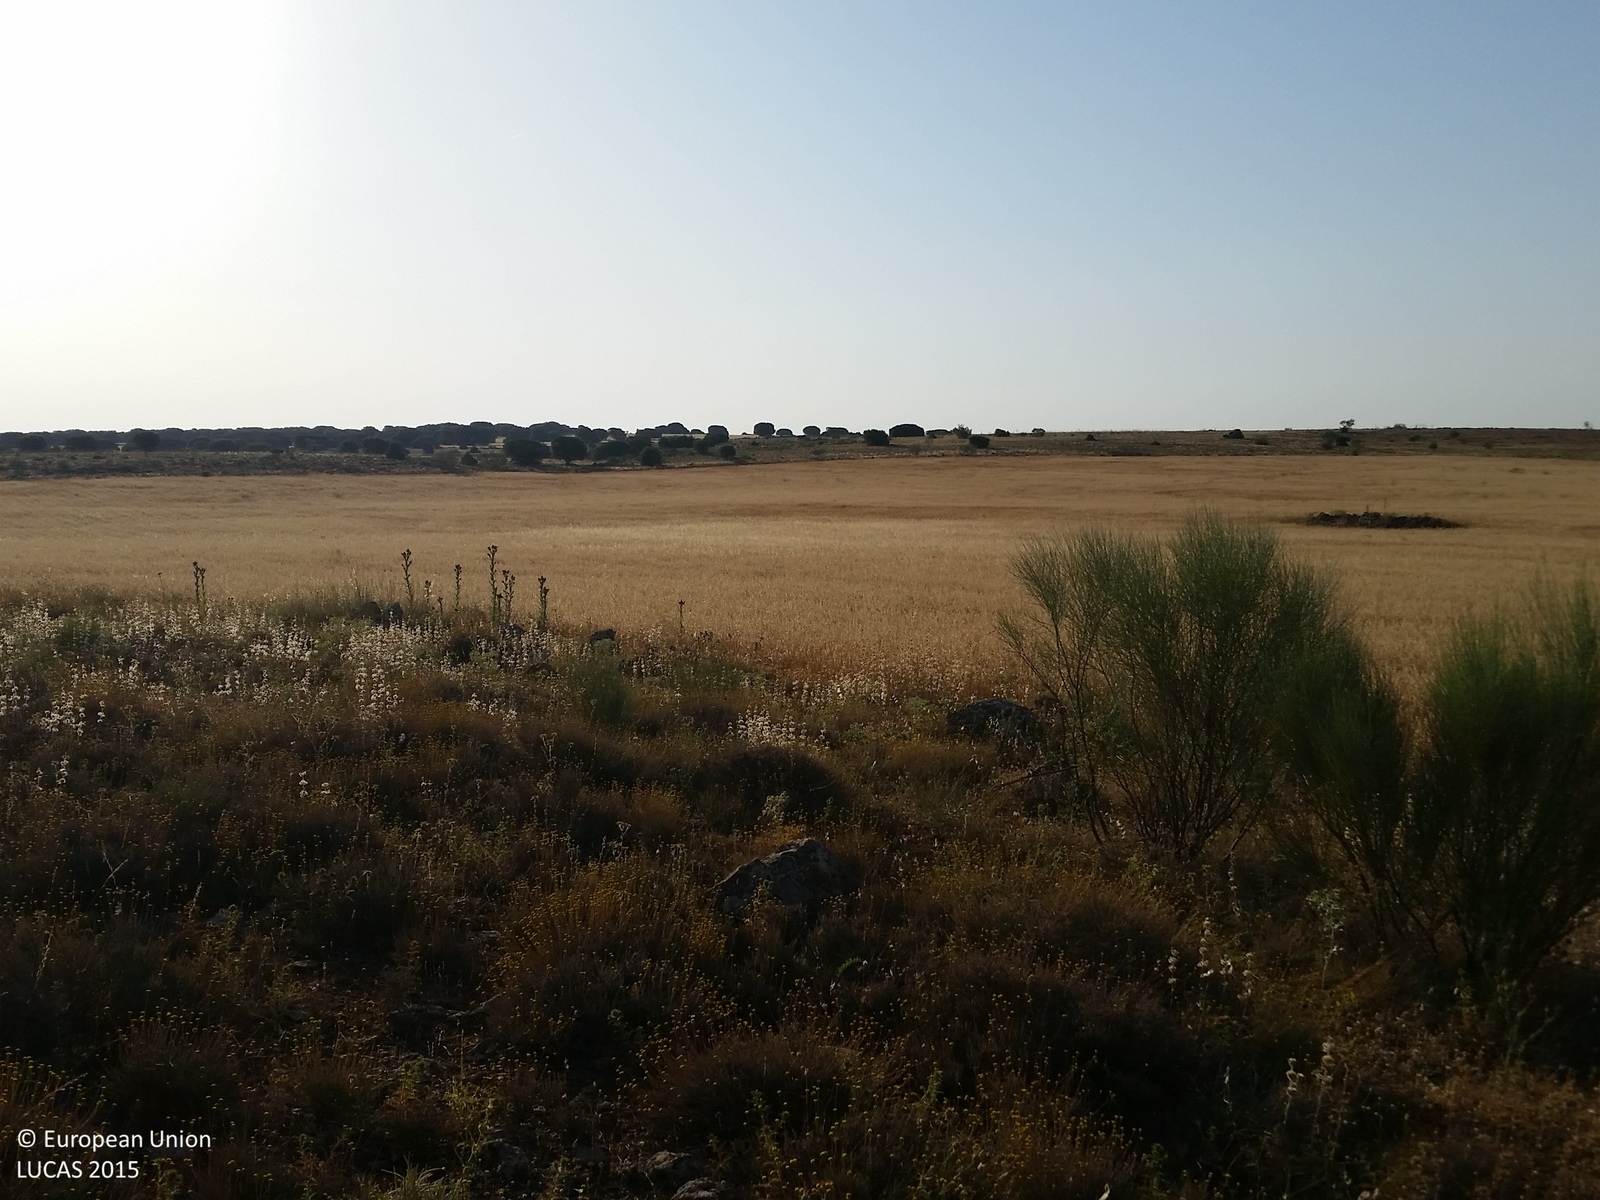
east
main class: Shrubland
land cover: Shrubland without tree cover
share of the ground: > 75 %
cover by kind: shrubs 75 %, herbaceous plants 15 %, consolidated bare surface 10 %
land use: Semi-natural and natural areas not in use
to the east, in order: Shrubland without tree cover; Oats
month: June
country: ES
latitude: 38.7854
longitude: -2.6559
